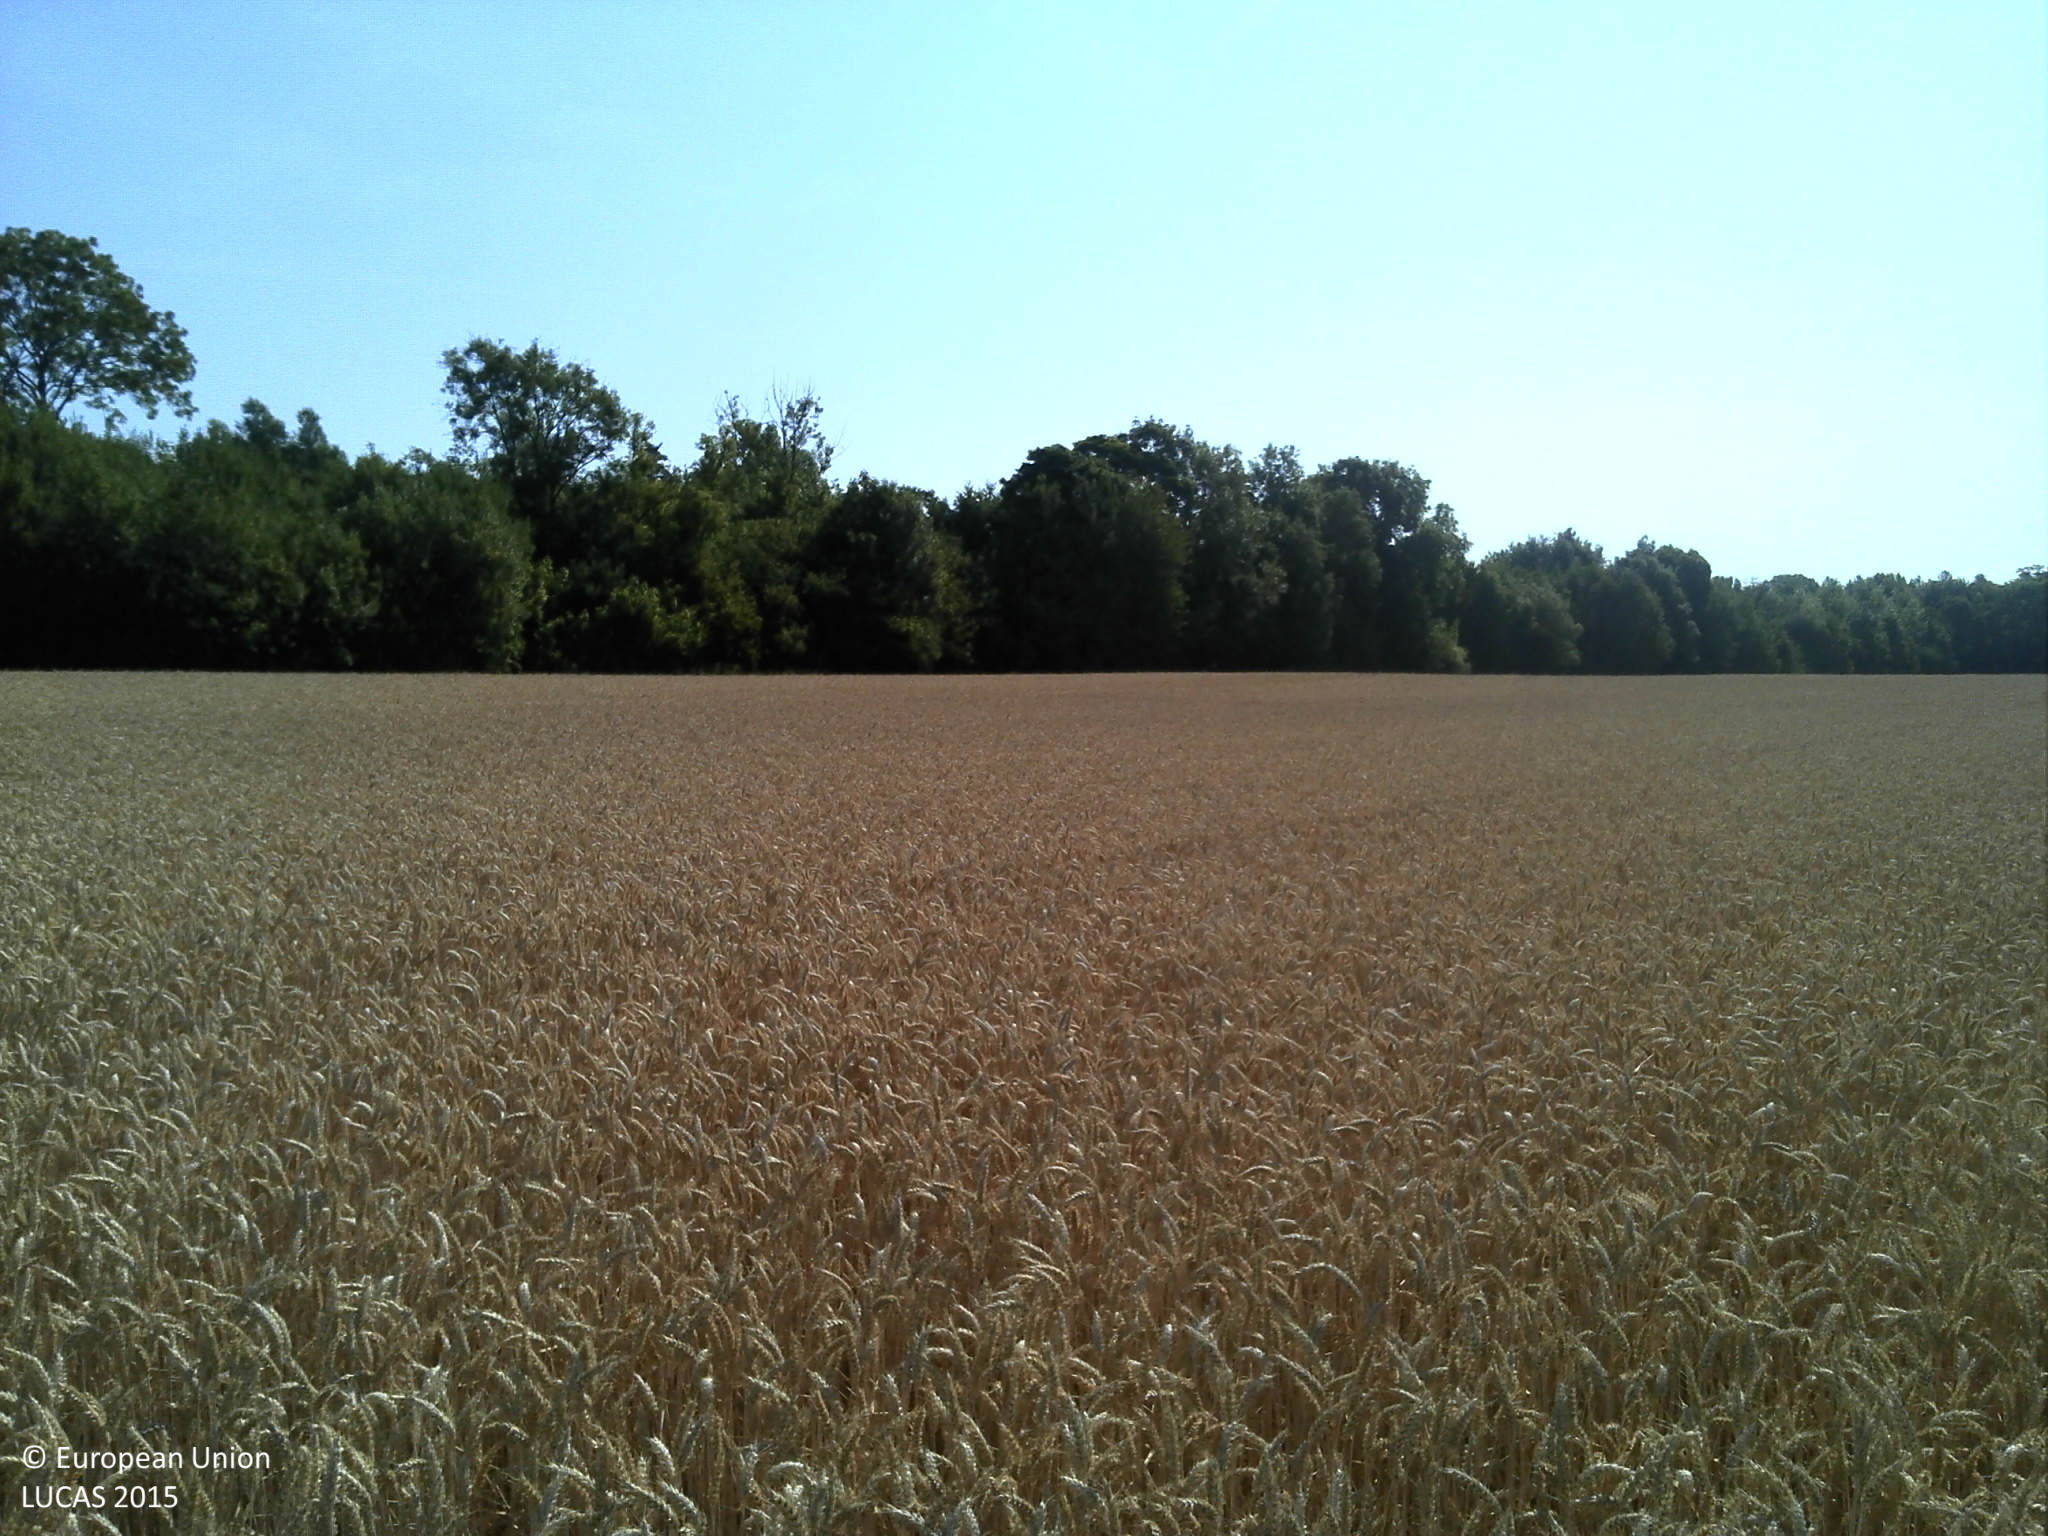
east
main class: Cropland
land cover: Common wheat
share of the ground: > 75 %
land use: Agriculture (excluding fallow land and kitchen gardens)
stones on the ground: < 10 %
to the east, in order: Common wheat; Tracks; Broadleaved woodland; Spontaneously vegetated surfaces; Broadleaved woodland
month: July
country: FR
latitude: 49.4217
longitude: 4.1638
